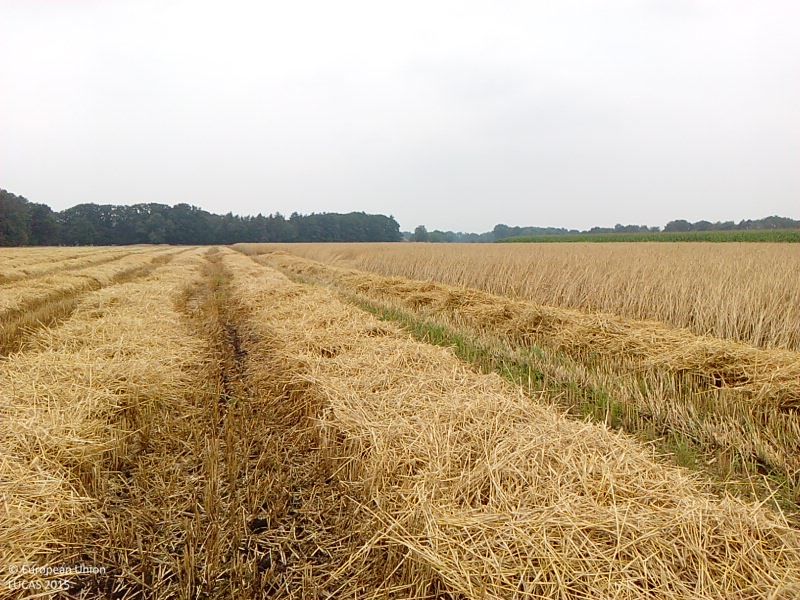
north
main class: Cropland
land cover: Rye
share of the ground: > 75 %
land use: Agriculture (excluding fallow land and kitchen gardens)
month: August
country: DE
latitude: 52.6553
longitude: 8.4778
